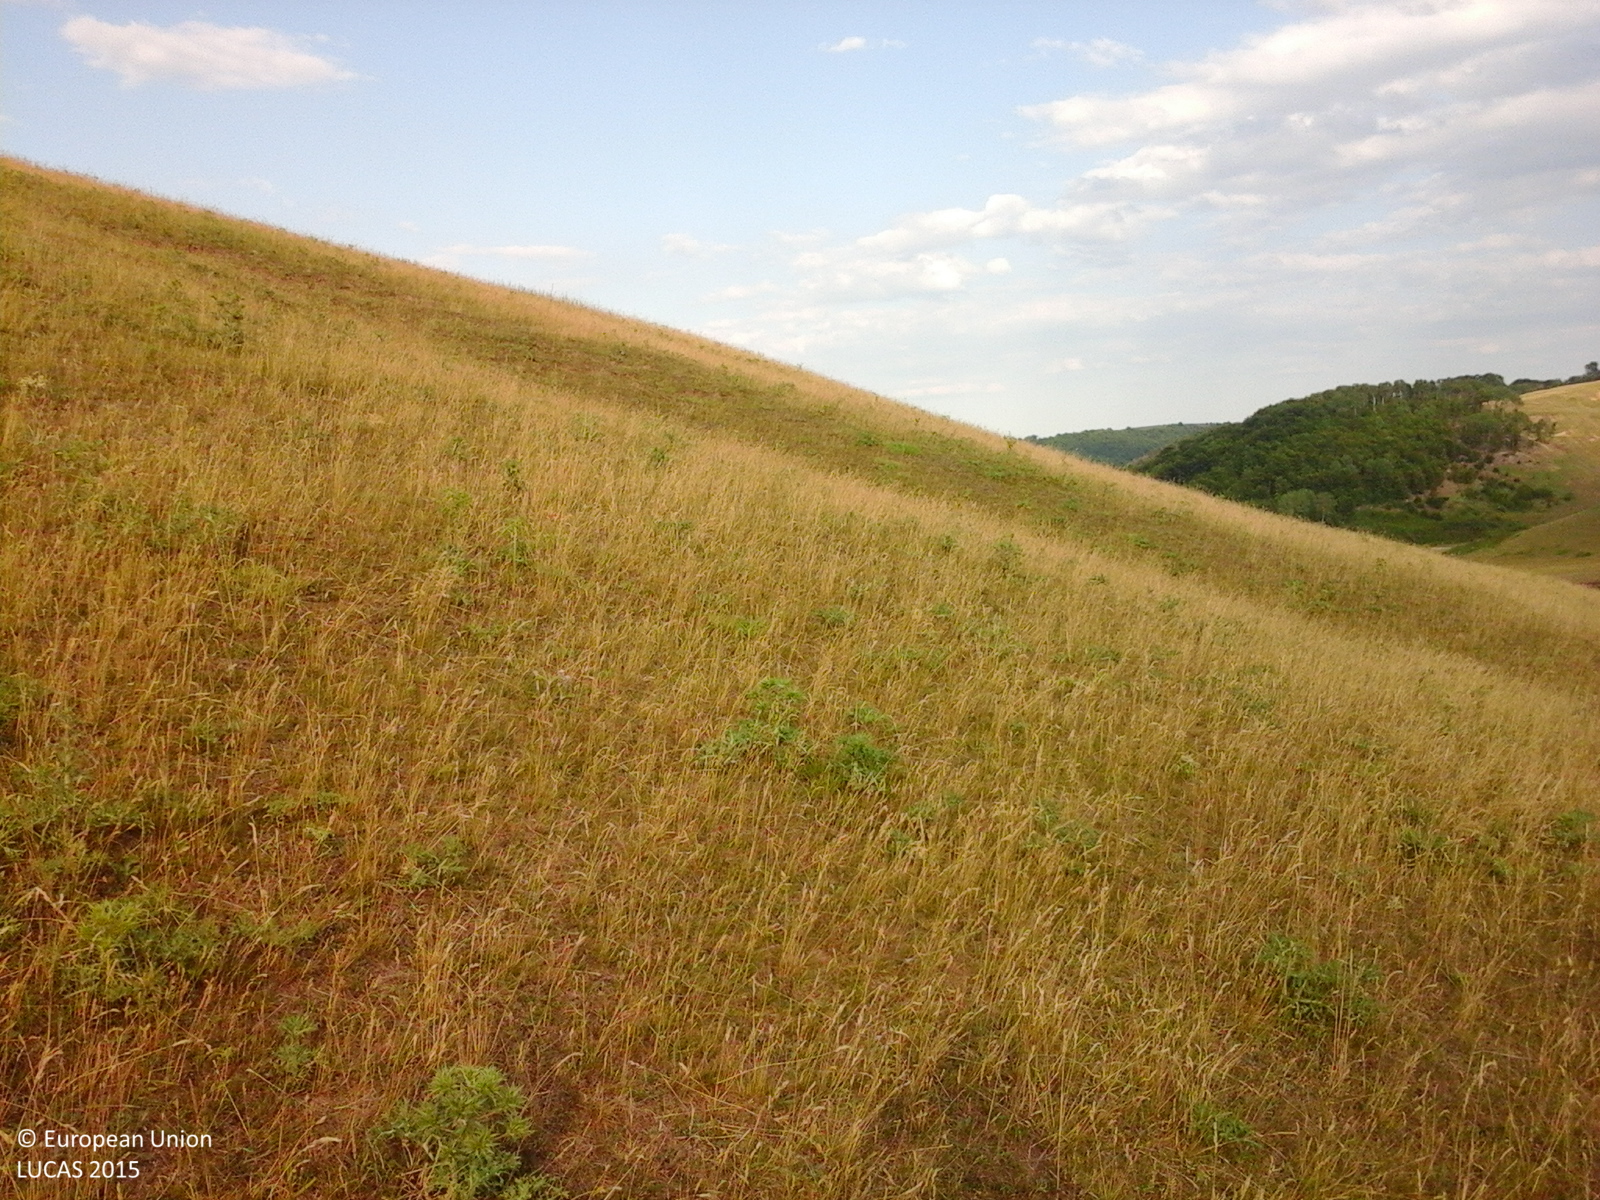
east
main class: Grassland
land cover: Grassland without tree/shrub cover
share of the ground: > 75 %
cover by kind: herbaceous plants 100 %
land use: Agriculture (excluding fallow land and kitchen gardens)
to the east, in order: Grassland without tree/shrub cover
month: June
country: RO
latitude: 47.5506
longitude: 26.4179
